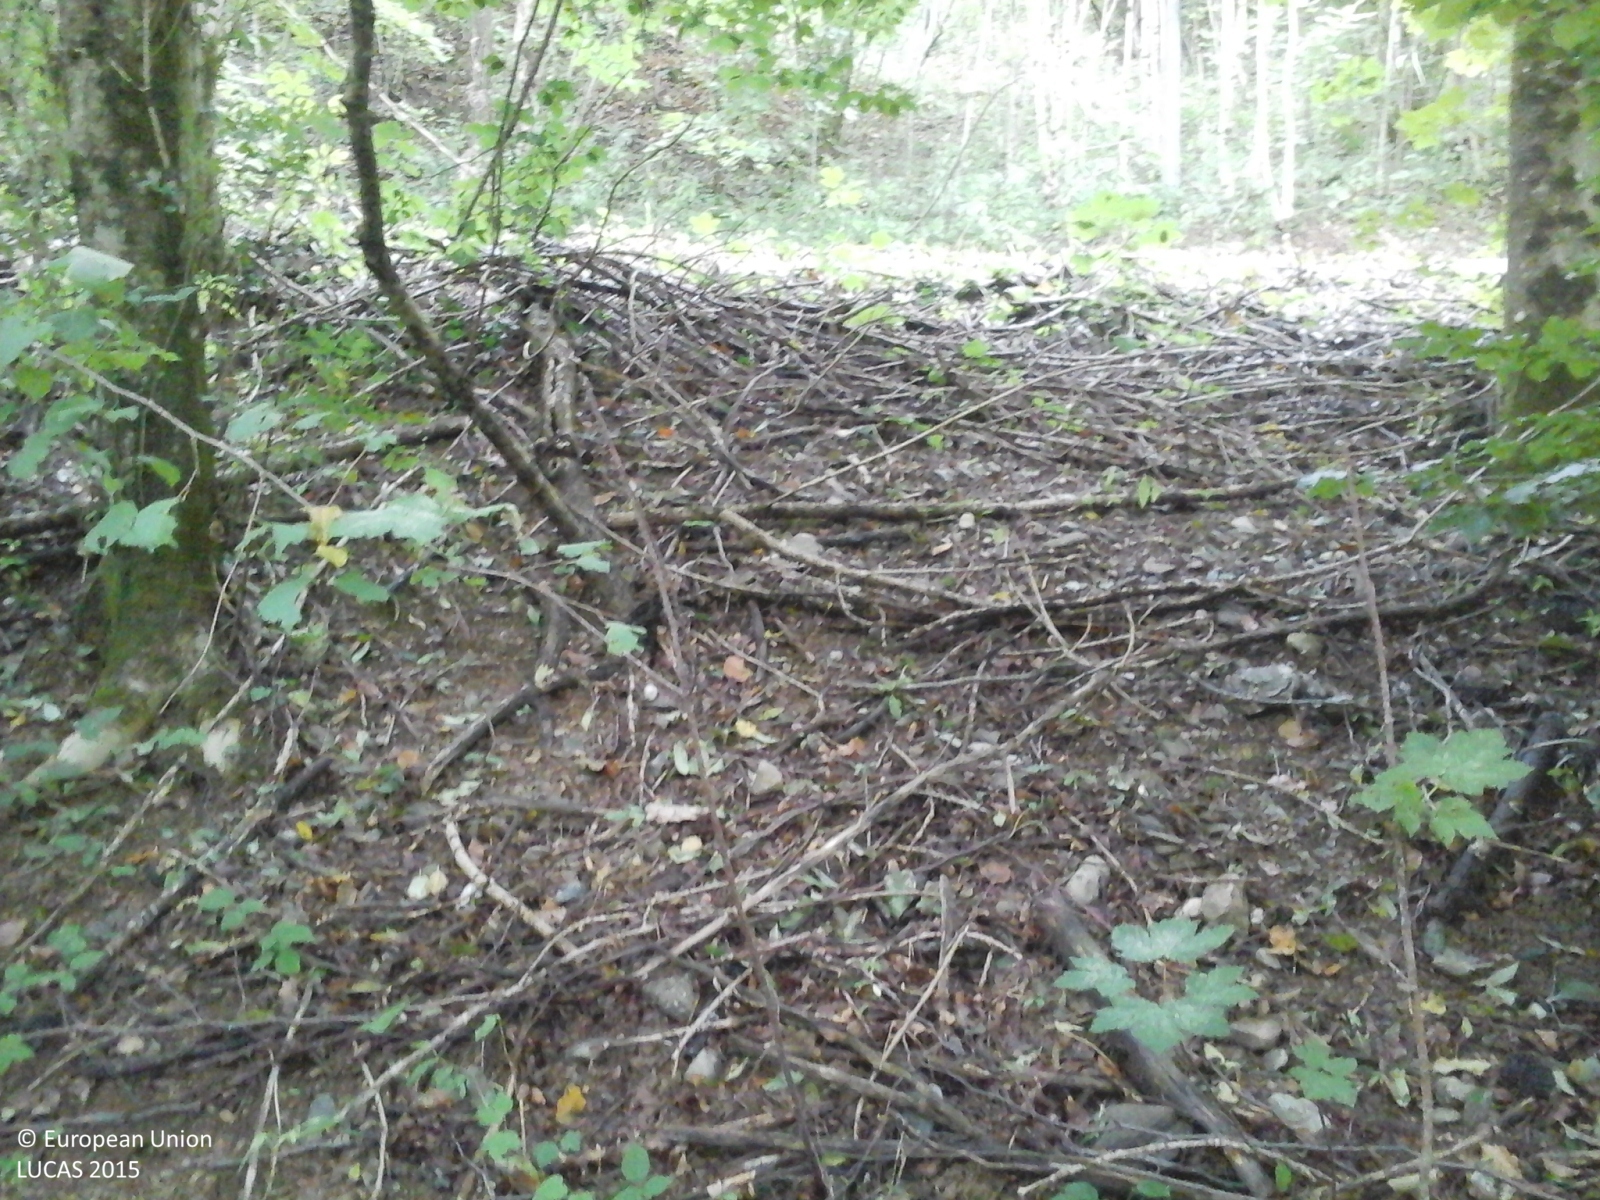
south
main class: Woodland
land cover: Broadleaved woodland
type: thermophilous deciduous forest
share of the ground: > 75 %
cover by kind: broadleaved forest trees 100 %
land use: Semi-natural and natural areas not in use
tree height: > 5 m
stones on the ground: 10 - 25 %
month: September
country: IT
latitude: 44.5099
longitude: 9.2093
